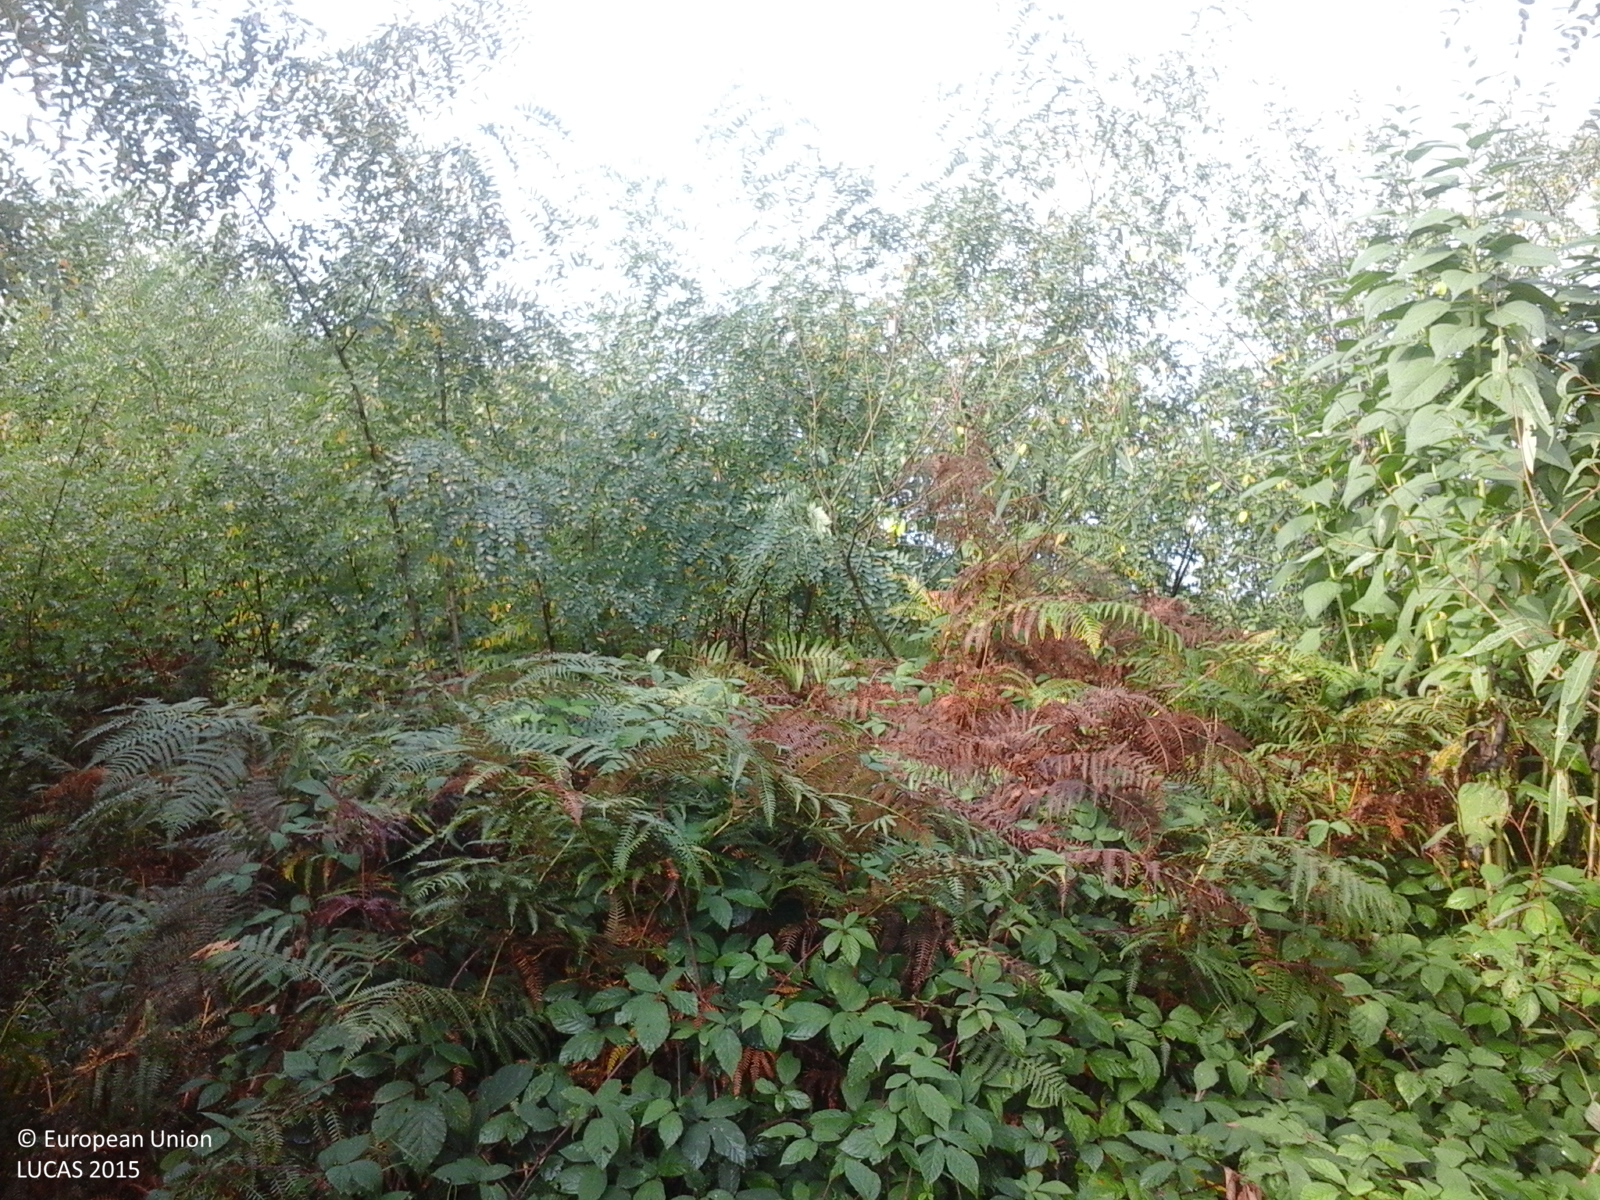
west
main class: Woodland
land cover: Broadleaved woodland
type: exotic forest
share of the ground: > 75 %
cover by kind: broadleaved forest trees 100 %
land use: Forestry
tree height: > 5 m
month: September
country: RO
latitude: 45.5205
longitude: 22.3723
